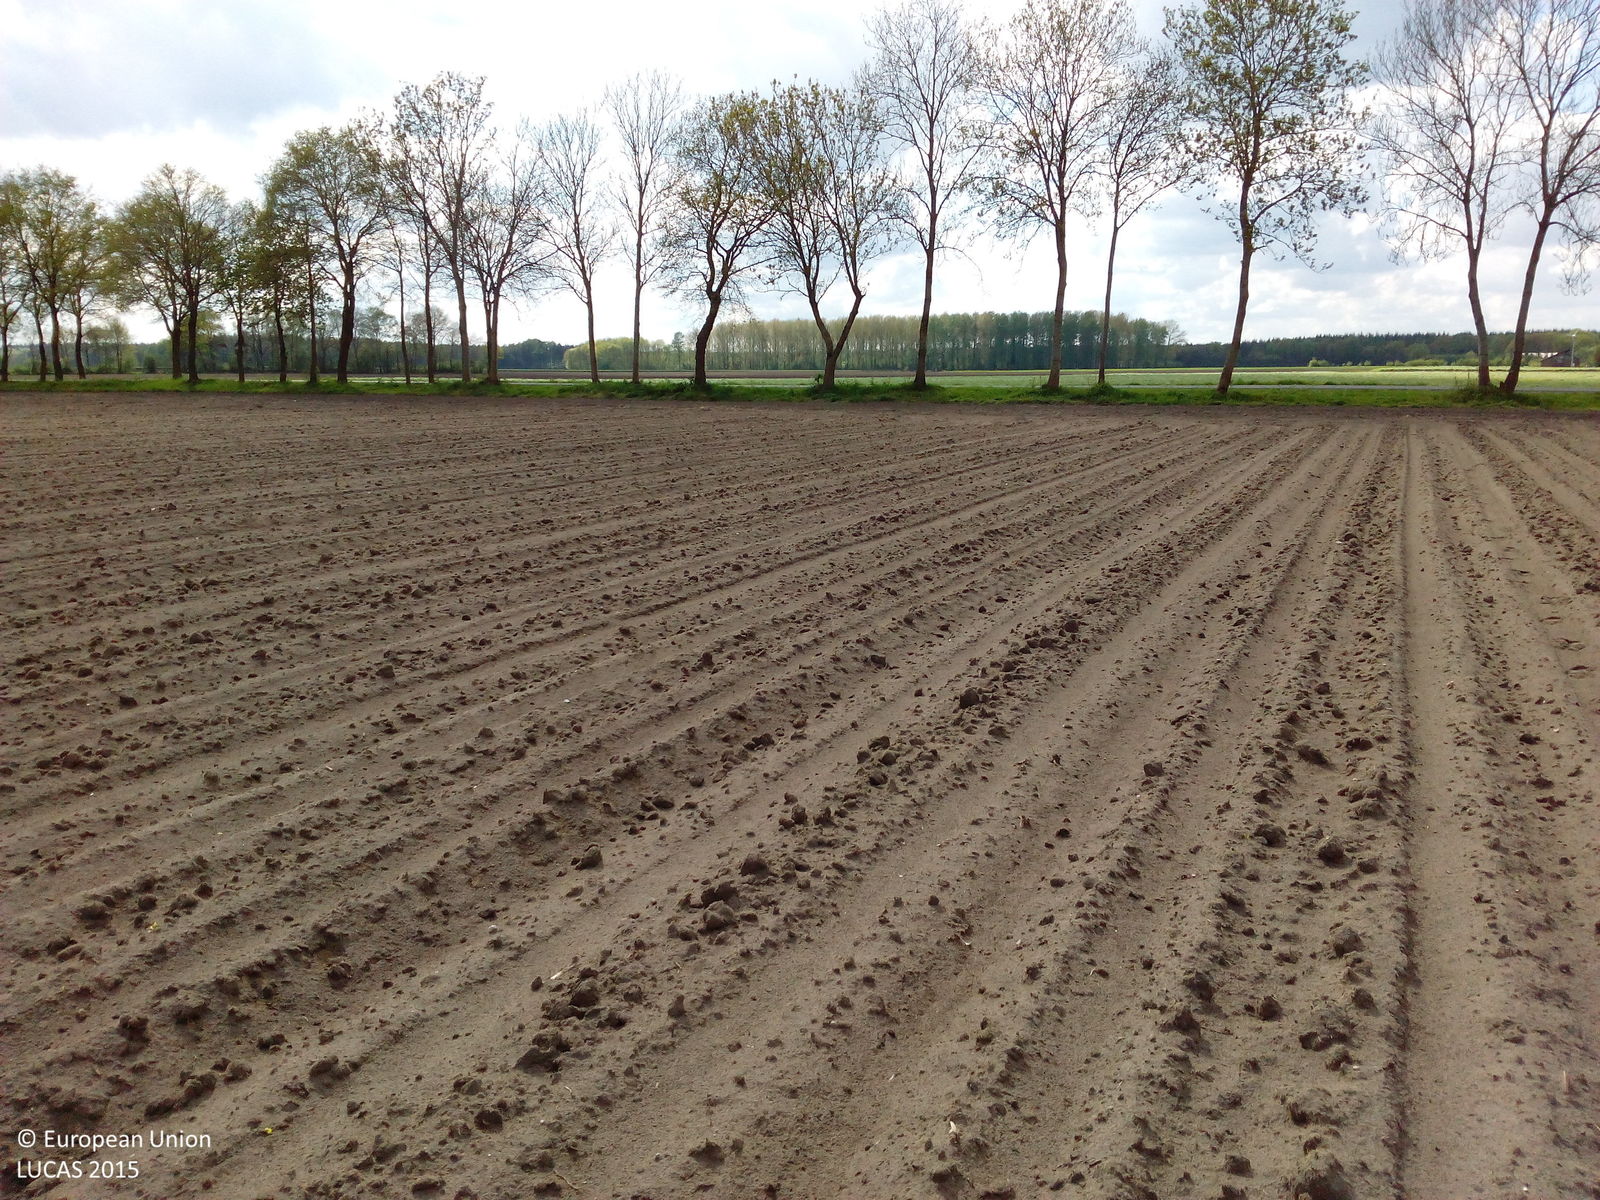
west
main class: Cropland
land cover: Sugar beet
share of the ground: < 10 %
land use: Agriculture (excluding fallow land and kitchen gardens)
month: May
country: DE
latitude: 52.9179
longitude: 7.9928
